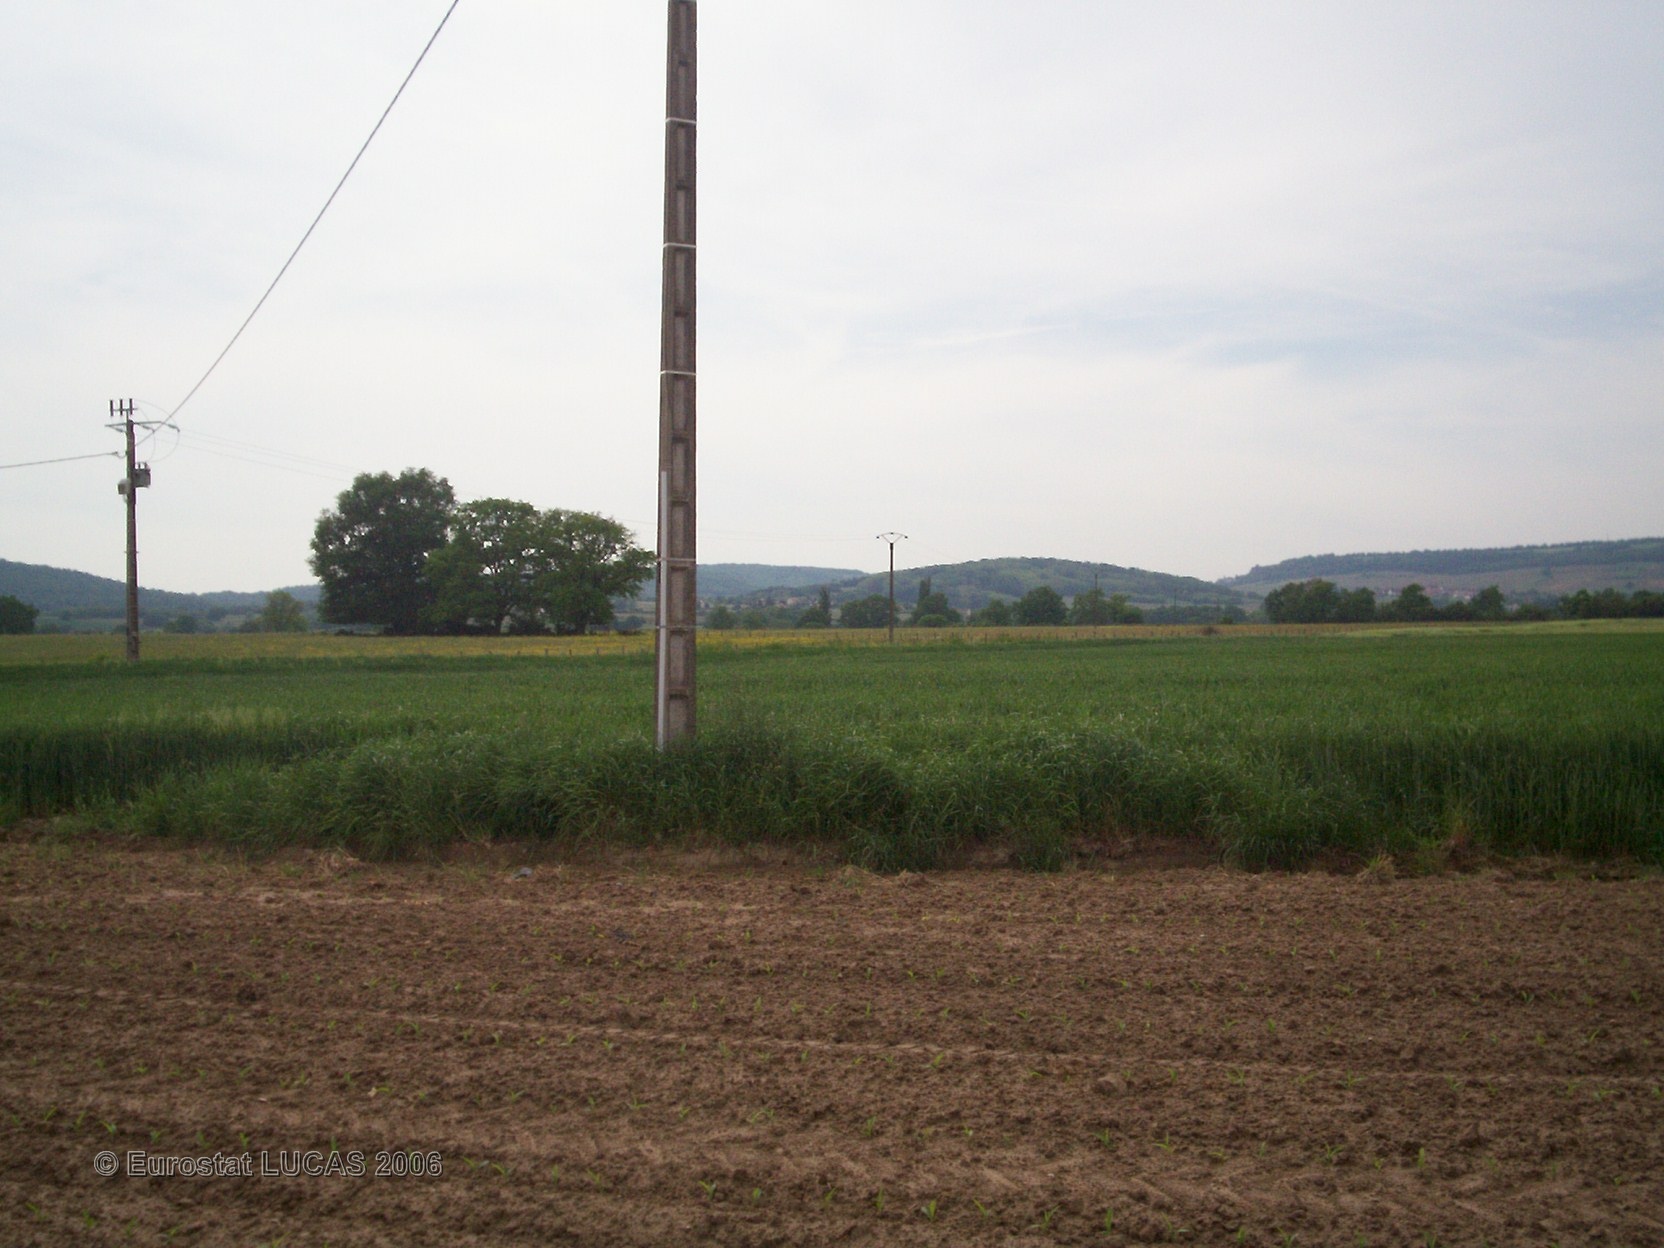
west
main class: Cropland
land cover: Maize
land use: Agriculture (excluding fallow land and kitchen gardens)
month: May
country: FR
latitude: 46.6534
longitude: 4.7092
